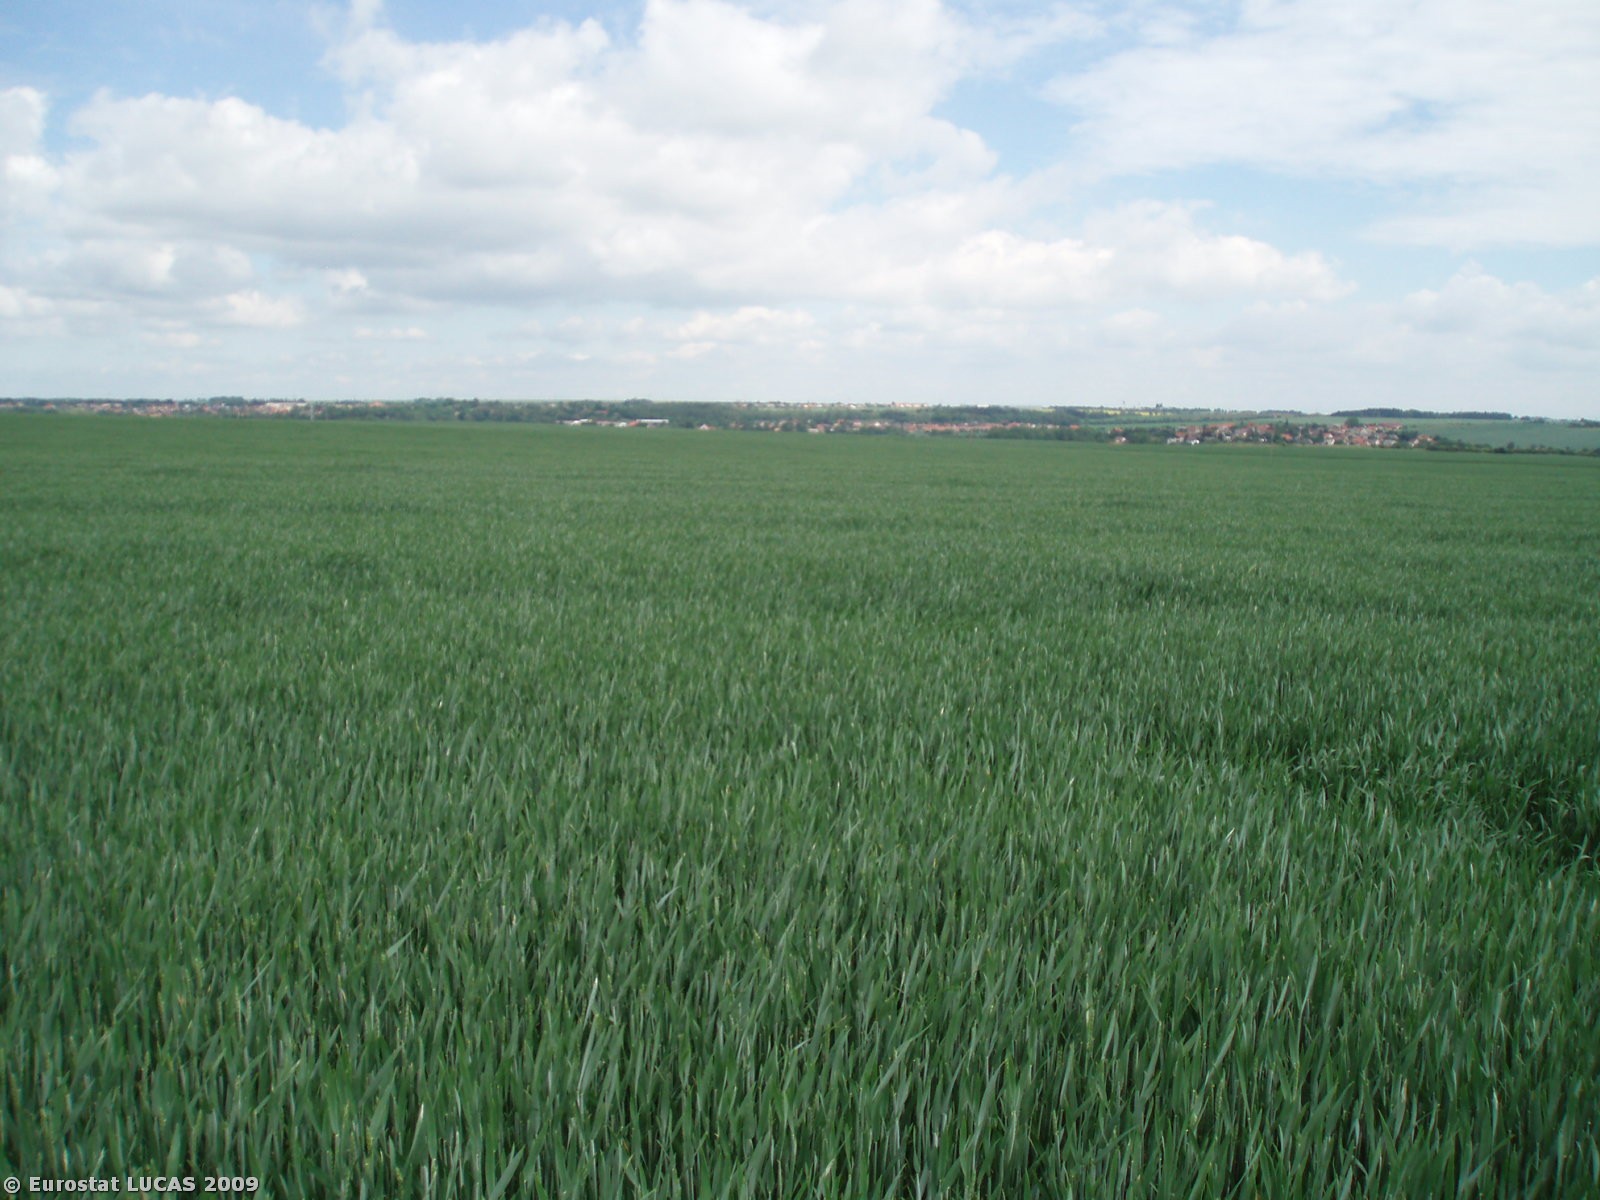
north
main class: Cropland
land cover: Common wheat
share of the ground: > 75 %
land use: Agriculture (excluding fallow land and kitchen gardens)
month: May
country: CZ
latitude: 49.9978
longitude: 14.2282
